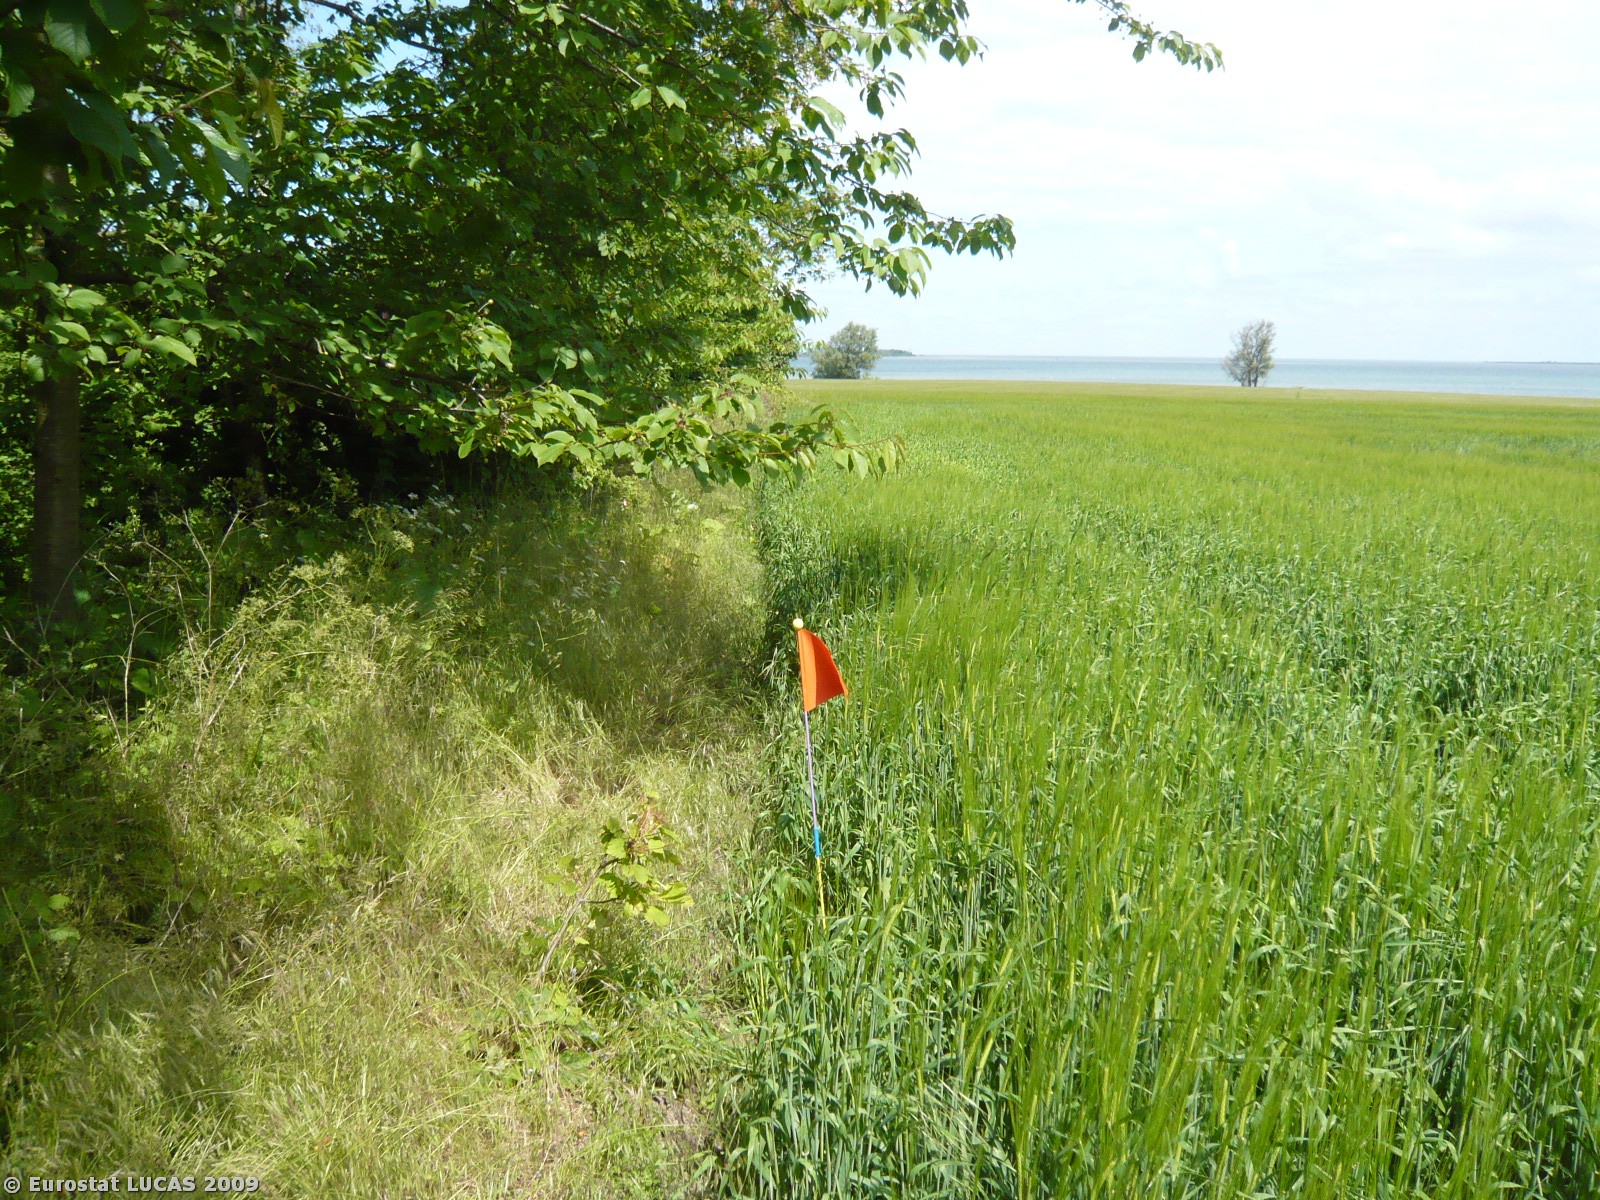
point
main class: Cropland
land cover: Barley
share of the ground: > 75 %
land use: Agriculture (excluding fallow land and kitchen gardens)
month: June
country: DK
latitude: 54.9408
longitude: 11.2947
